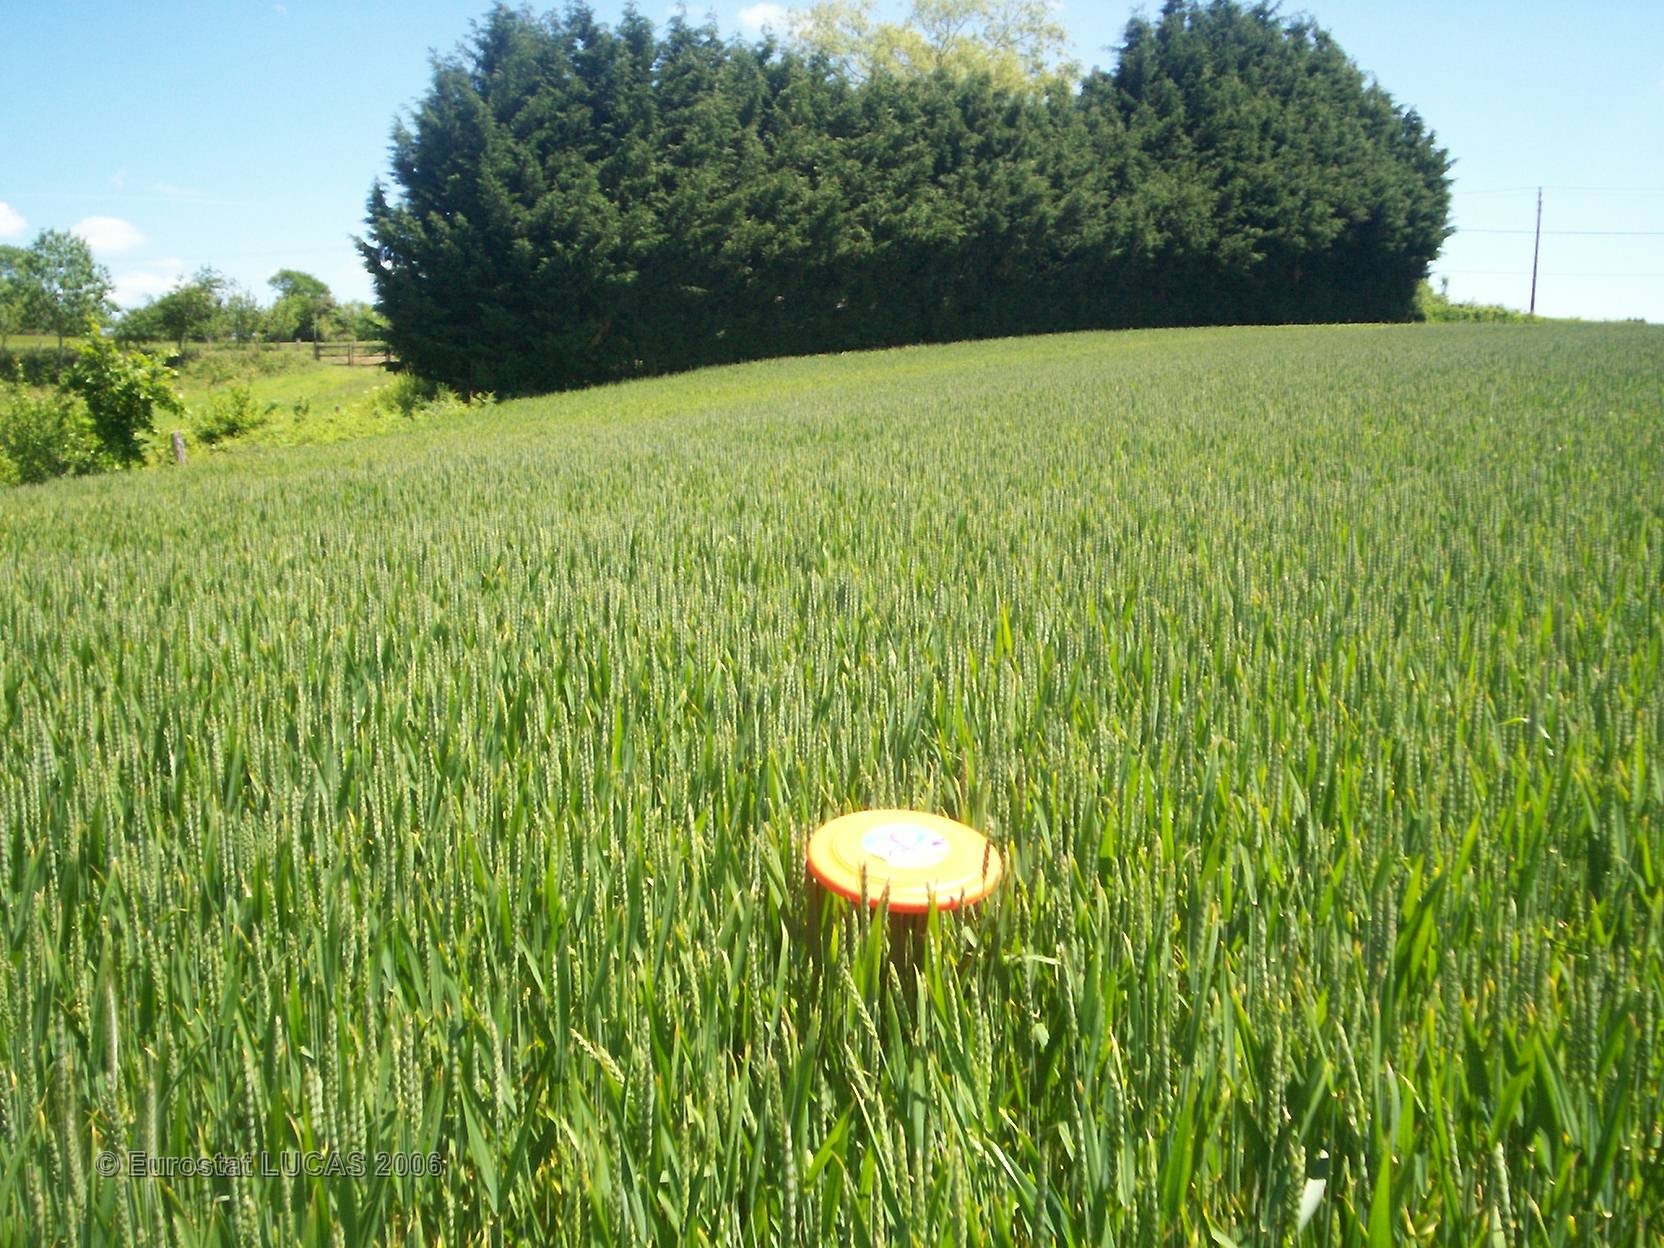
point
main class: Cropland
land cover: Common wheat
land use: Agriculture (excluding fallow land and kitchen gardens)
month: June
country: FR
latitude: 46.2581
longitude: 2.8753
